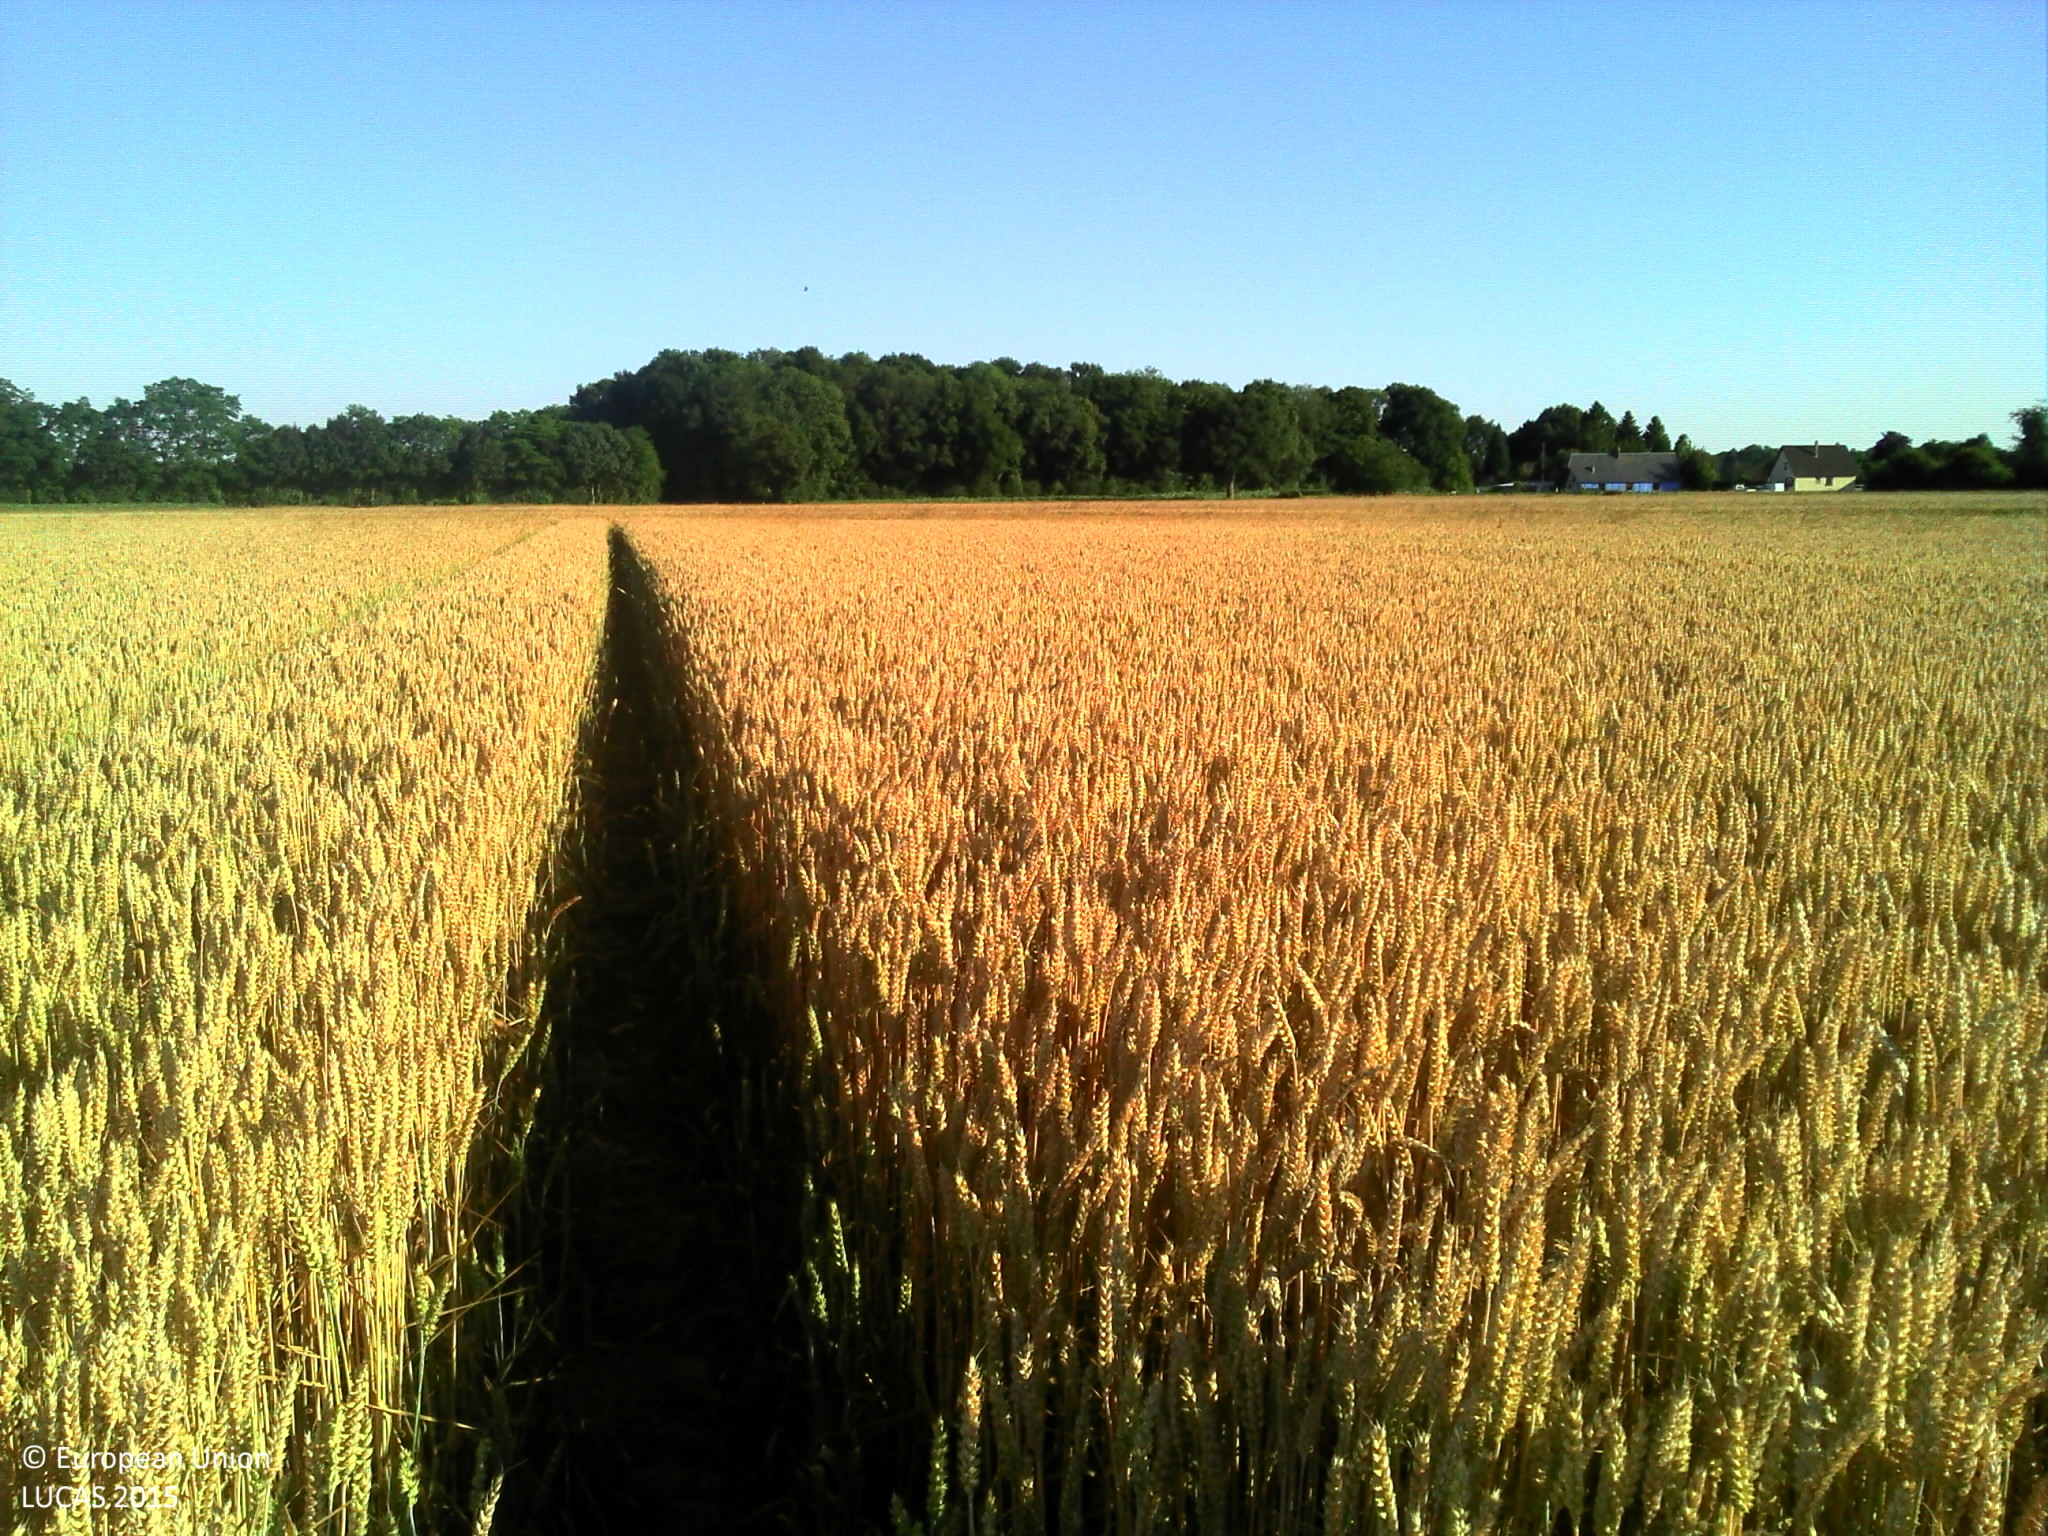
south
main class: Cropland
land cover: Common wheat
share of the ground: > 75 %
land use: Agriculture (excluding fallow land and kitchen gardens)
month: July
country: FR
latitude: 49.1132
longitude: 0.6731
